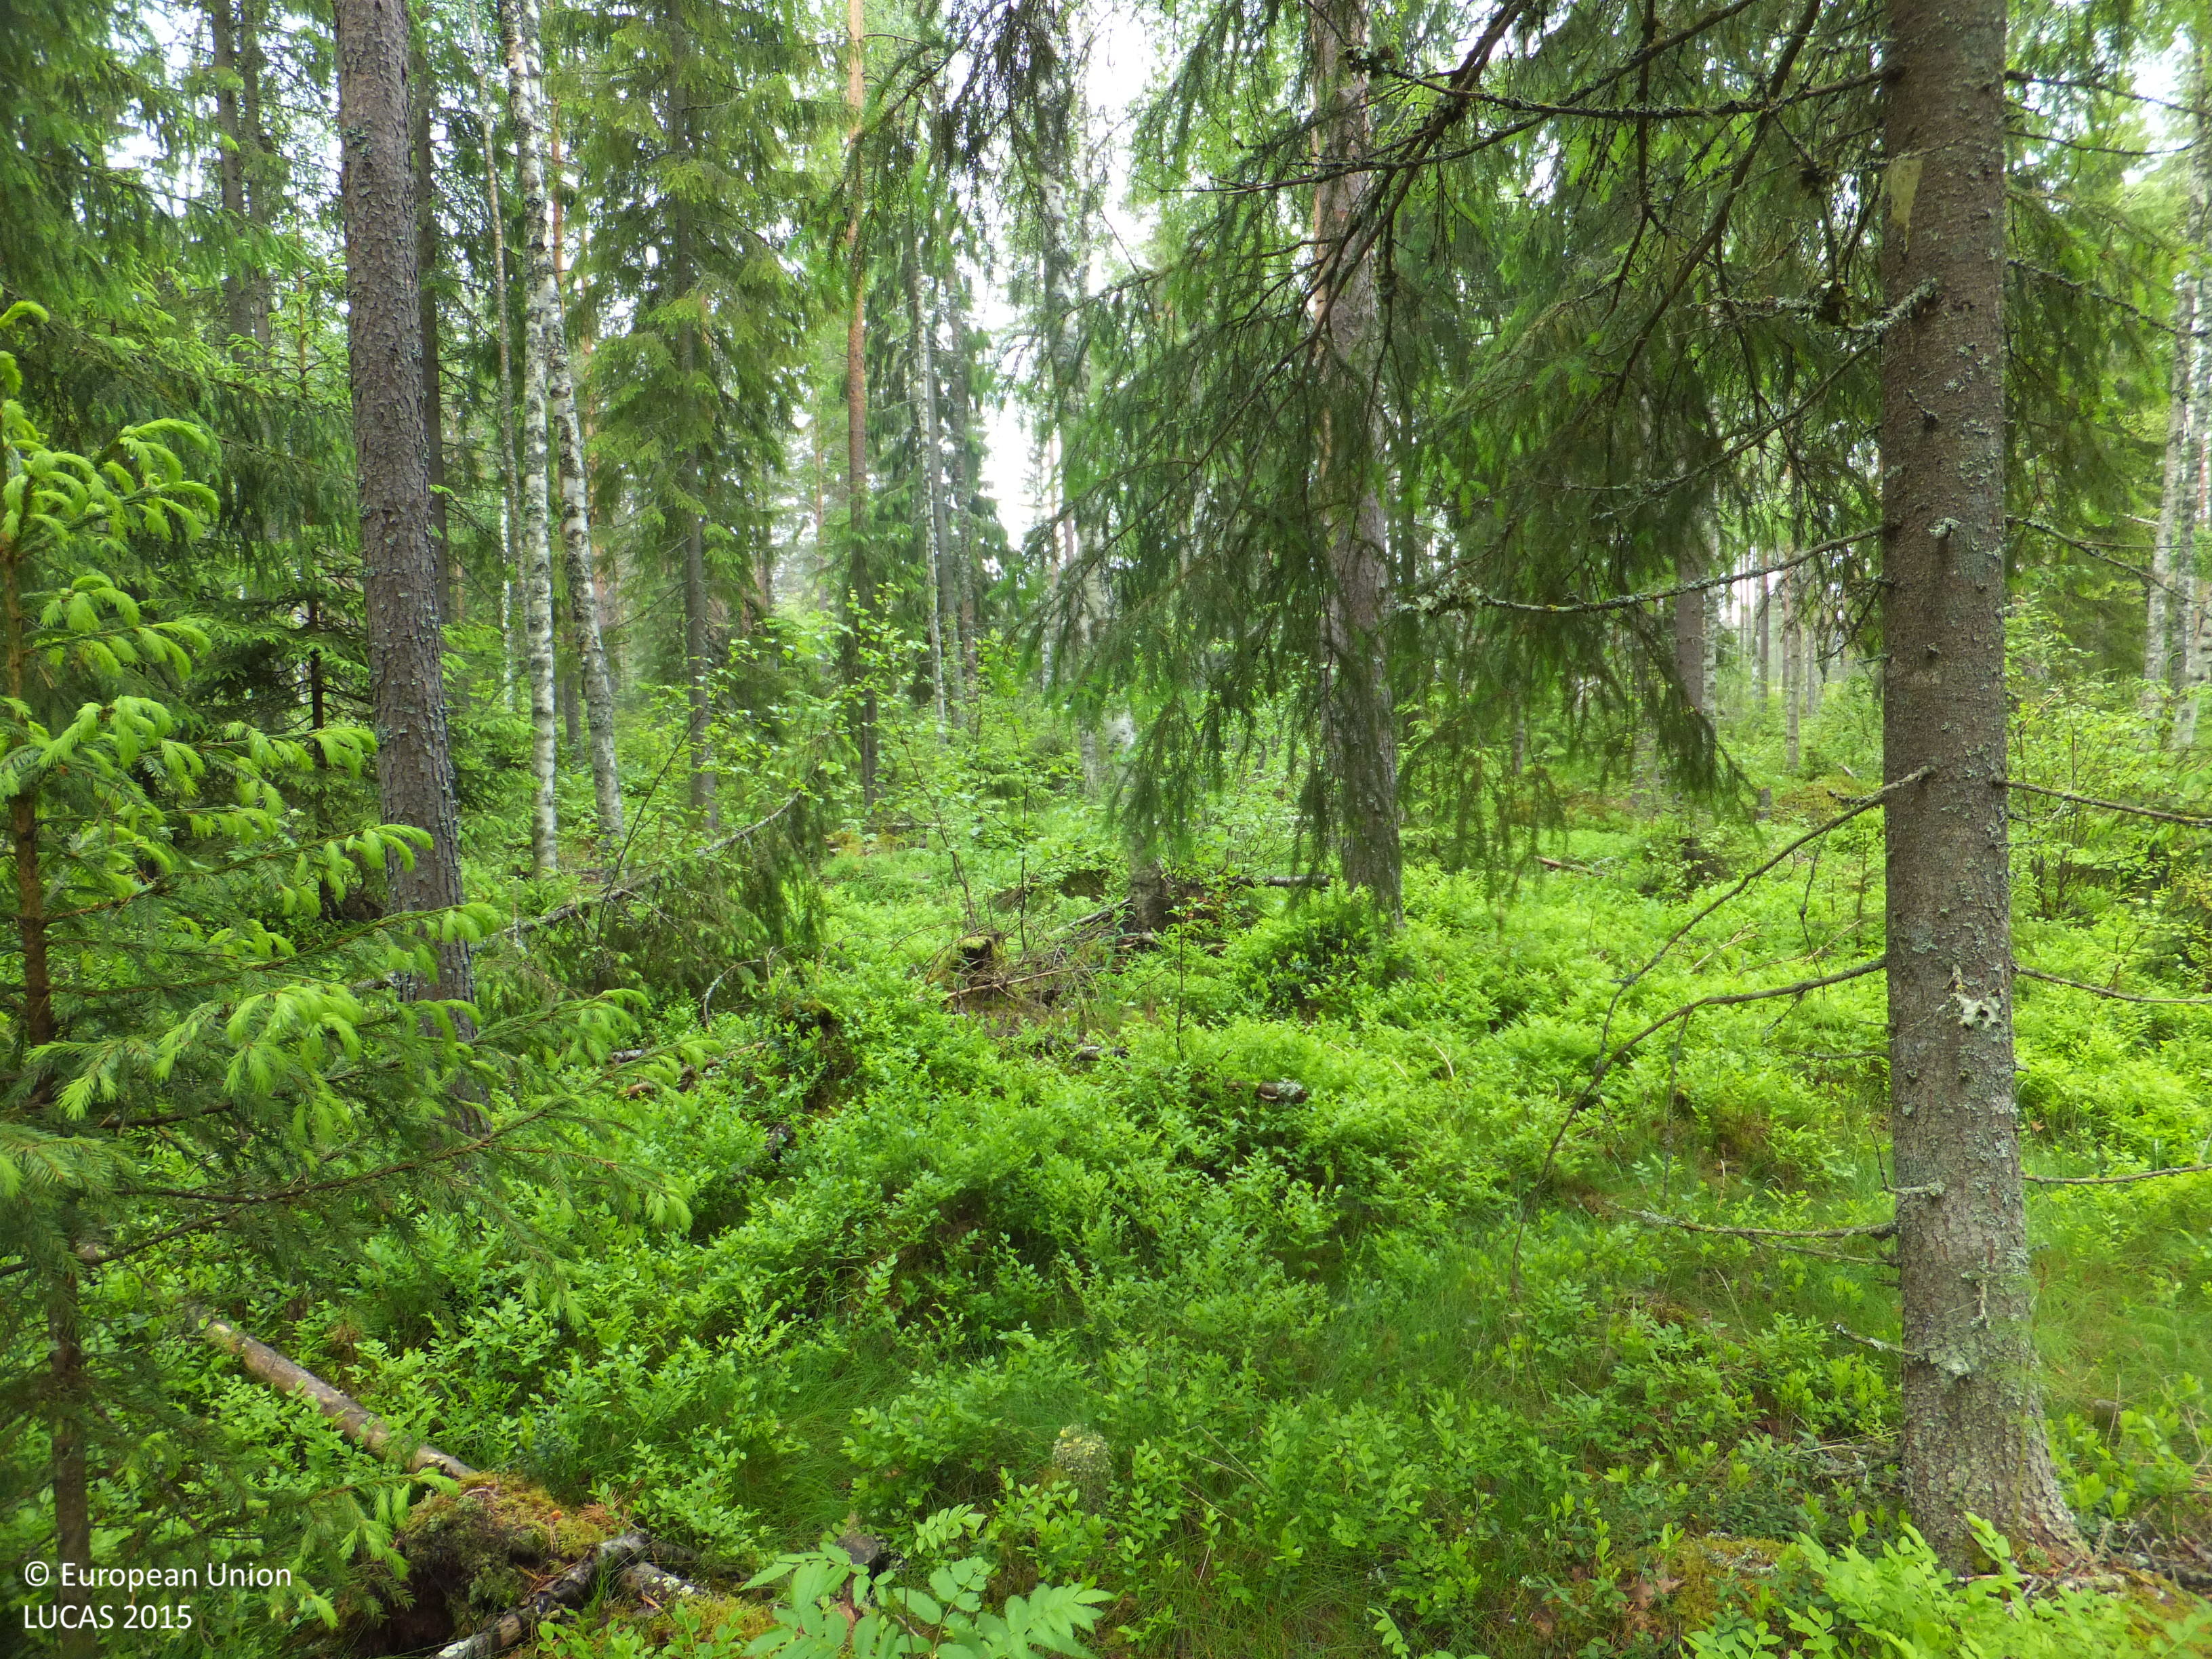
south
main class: Woodland
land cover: Other mixed woodland
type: boreal forest
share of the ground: > 75 %
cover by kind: coniferous forest trees 50 %, broadleaved forest trees 25 %, shrubs 15 %, lichens and mosses 10 %
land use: Forestry
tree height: > 5 m
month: June
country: FI
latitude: 63.4316
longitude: 23.9173
